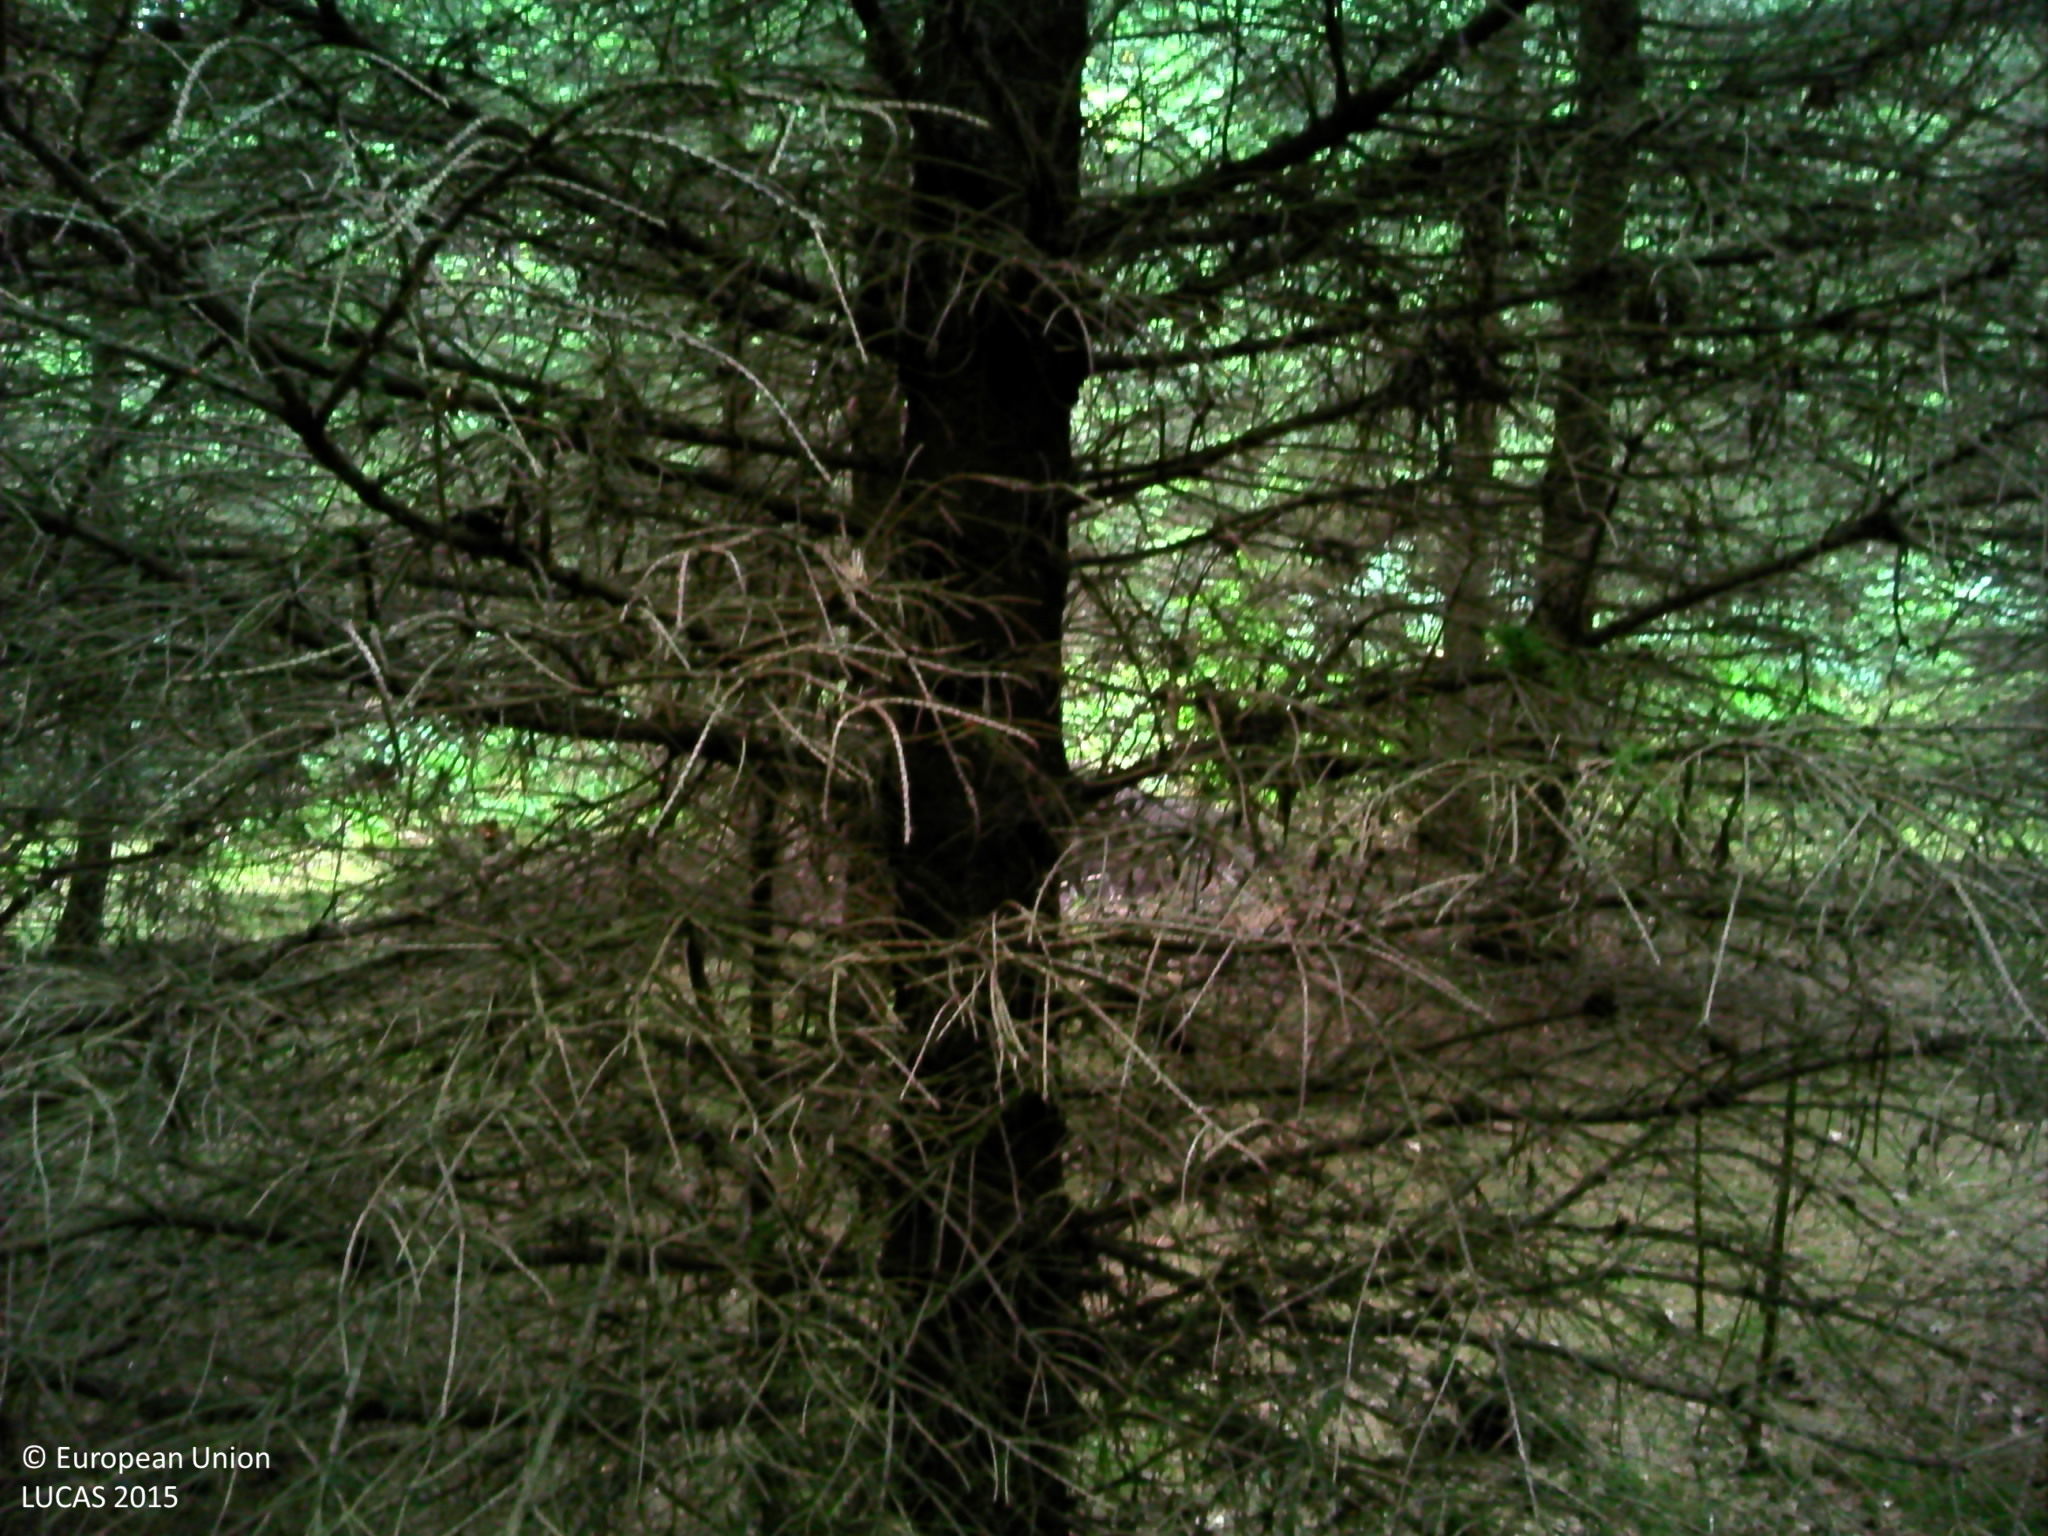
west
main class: Woodland
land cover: Spruce dominated coniferous woodland
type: hemiboreal forest and nemoral coniferous forest and mixed broadleaved-coniferous forest
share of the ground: > 75 %
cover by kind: coniferous forest trees 95 %, lichens and mosses 5 %
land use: Forestry
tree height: > 5 m
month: July
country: BE
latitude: 49.7930
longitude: 5.5950
